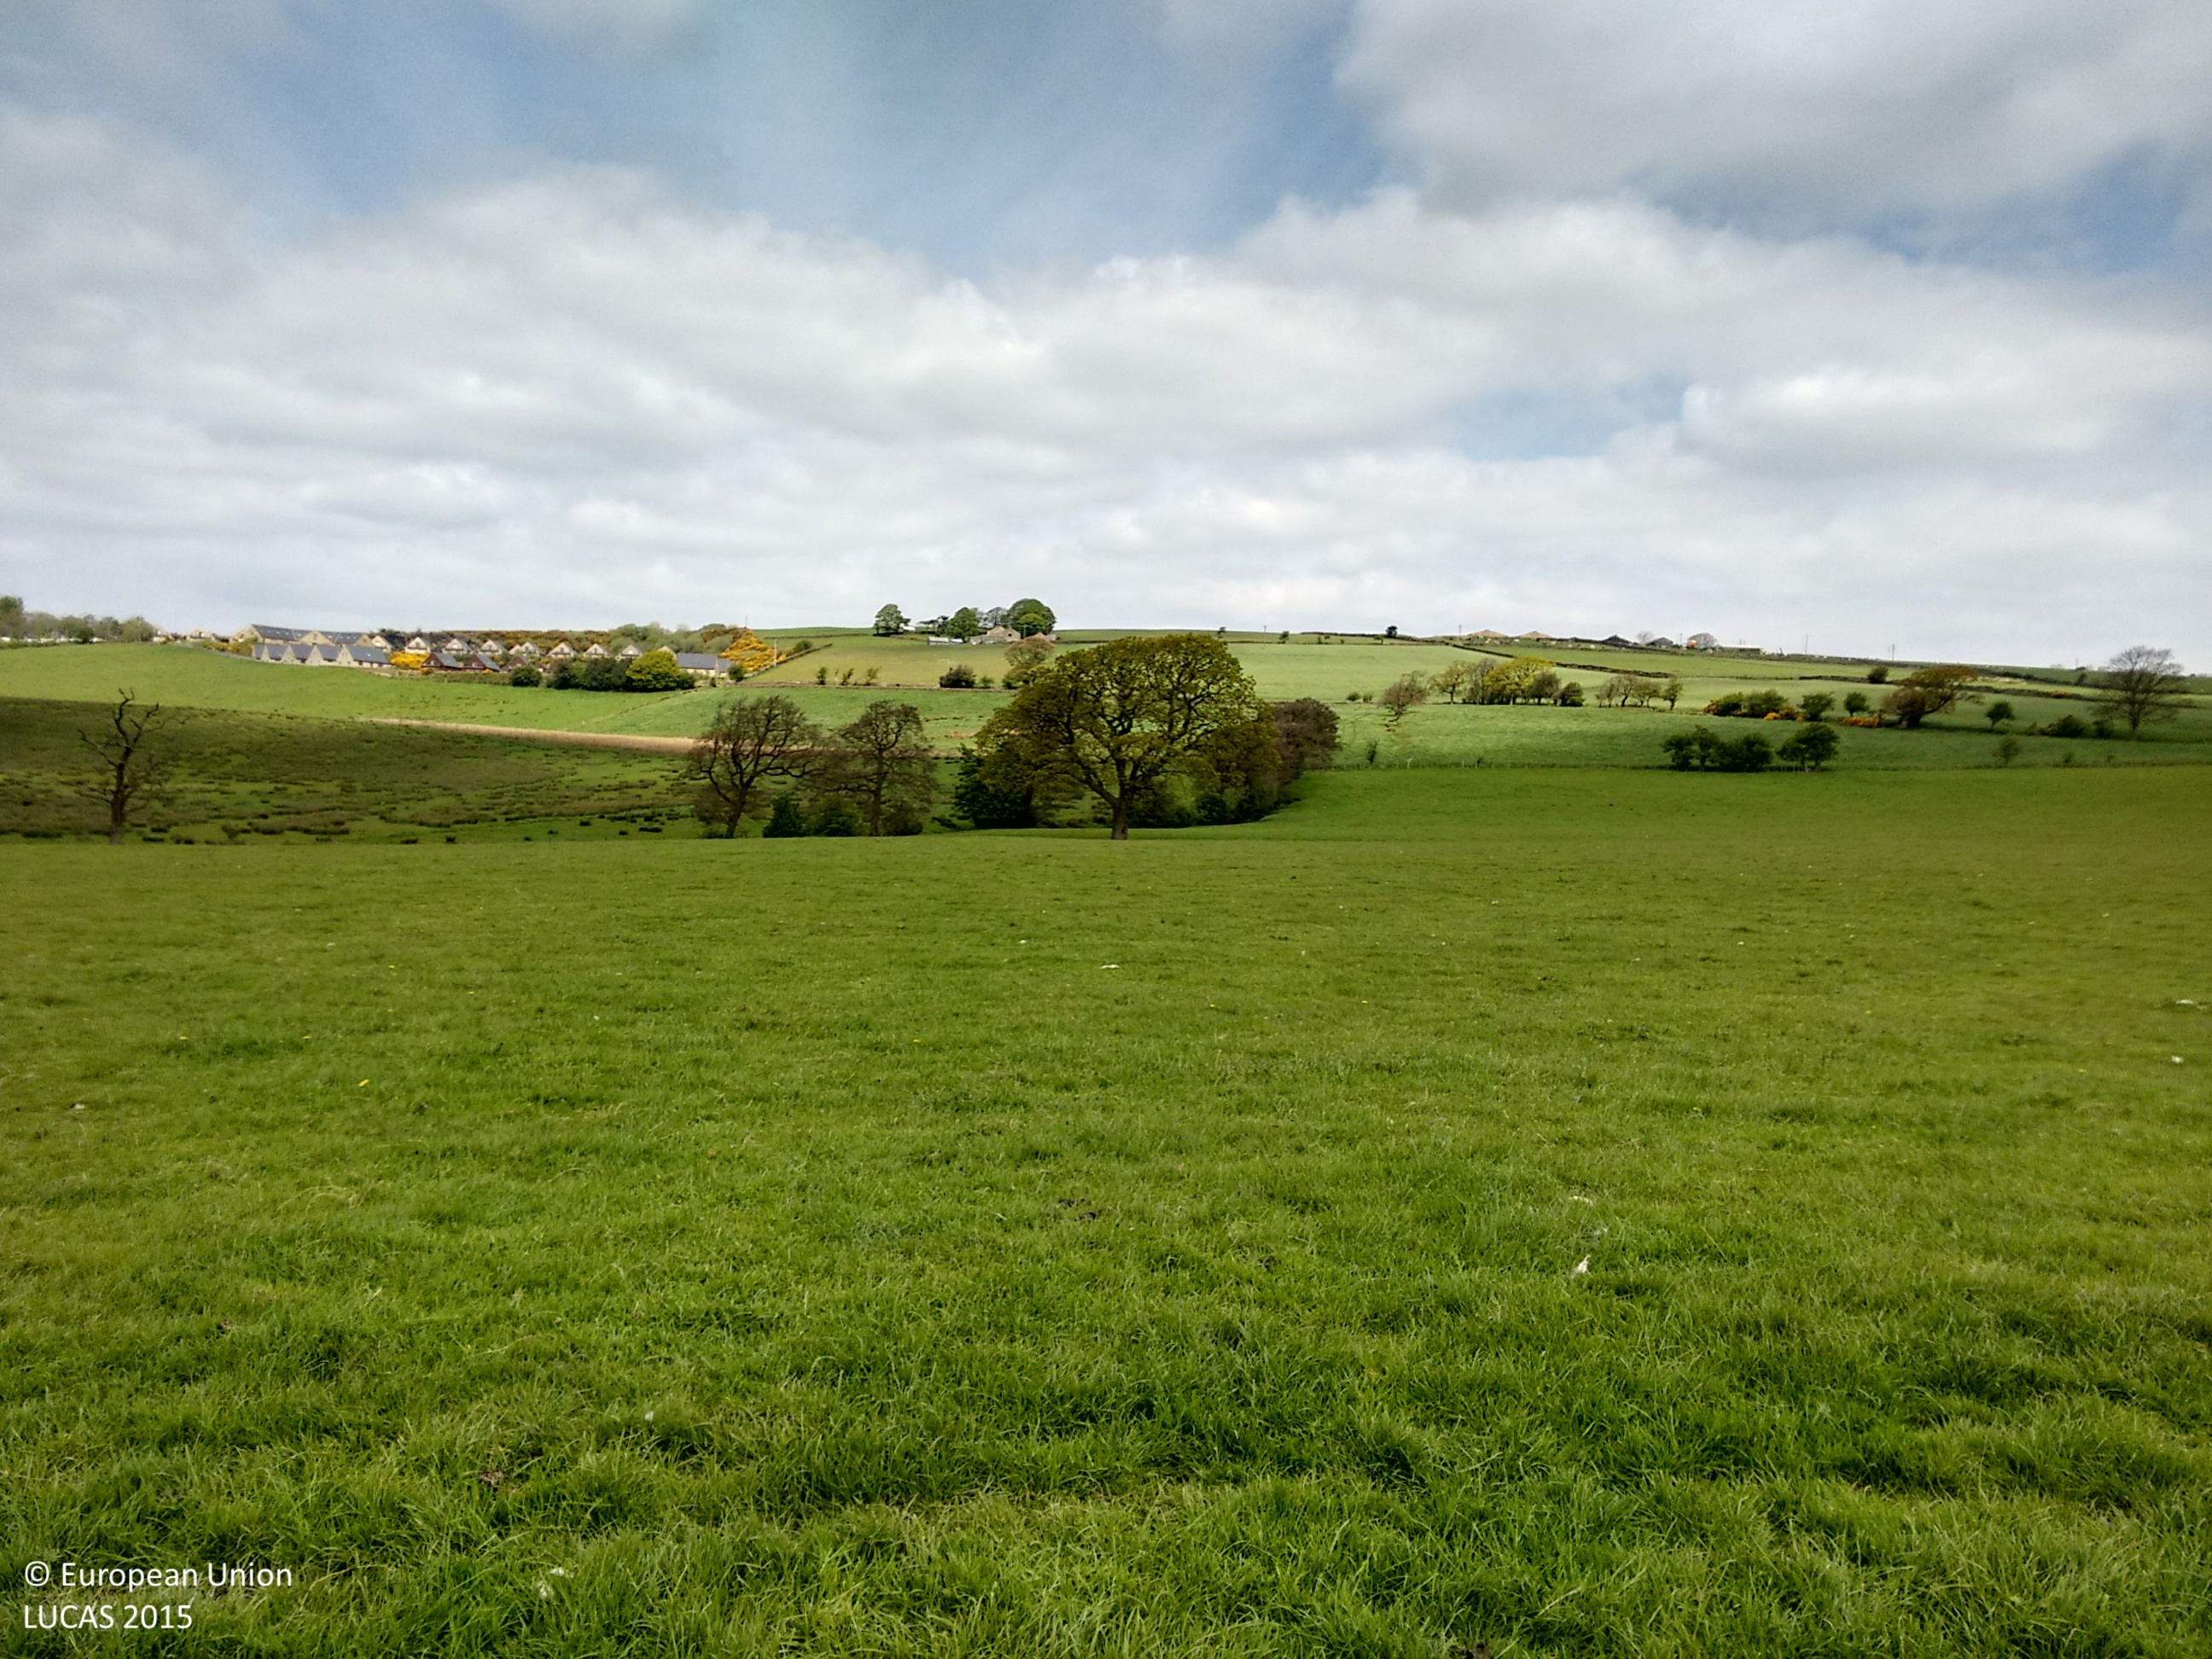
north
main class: Grassland
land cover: Grassland without tree/shrub cover
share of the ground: > 75 %
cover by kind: herbaceous plants 100 %
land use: Agriculture (excluding fallow land and kitchen gardens)
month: May
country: GB
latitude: 53.8359
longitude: -2.5724
